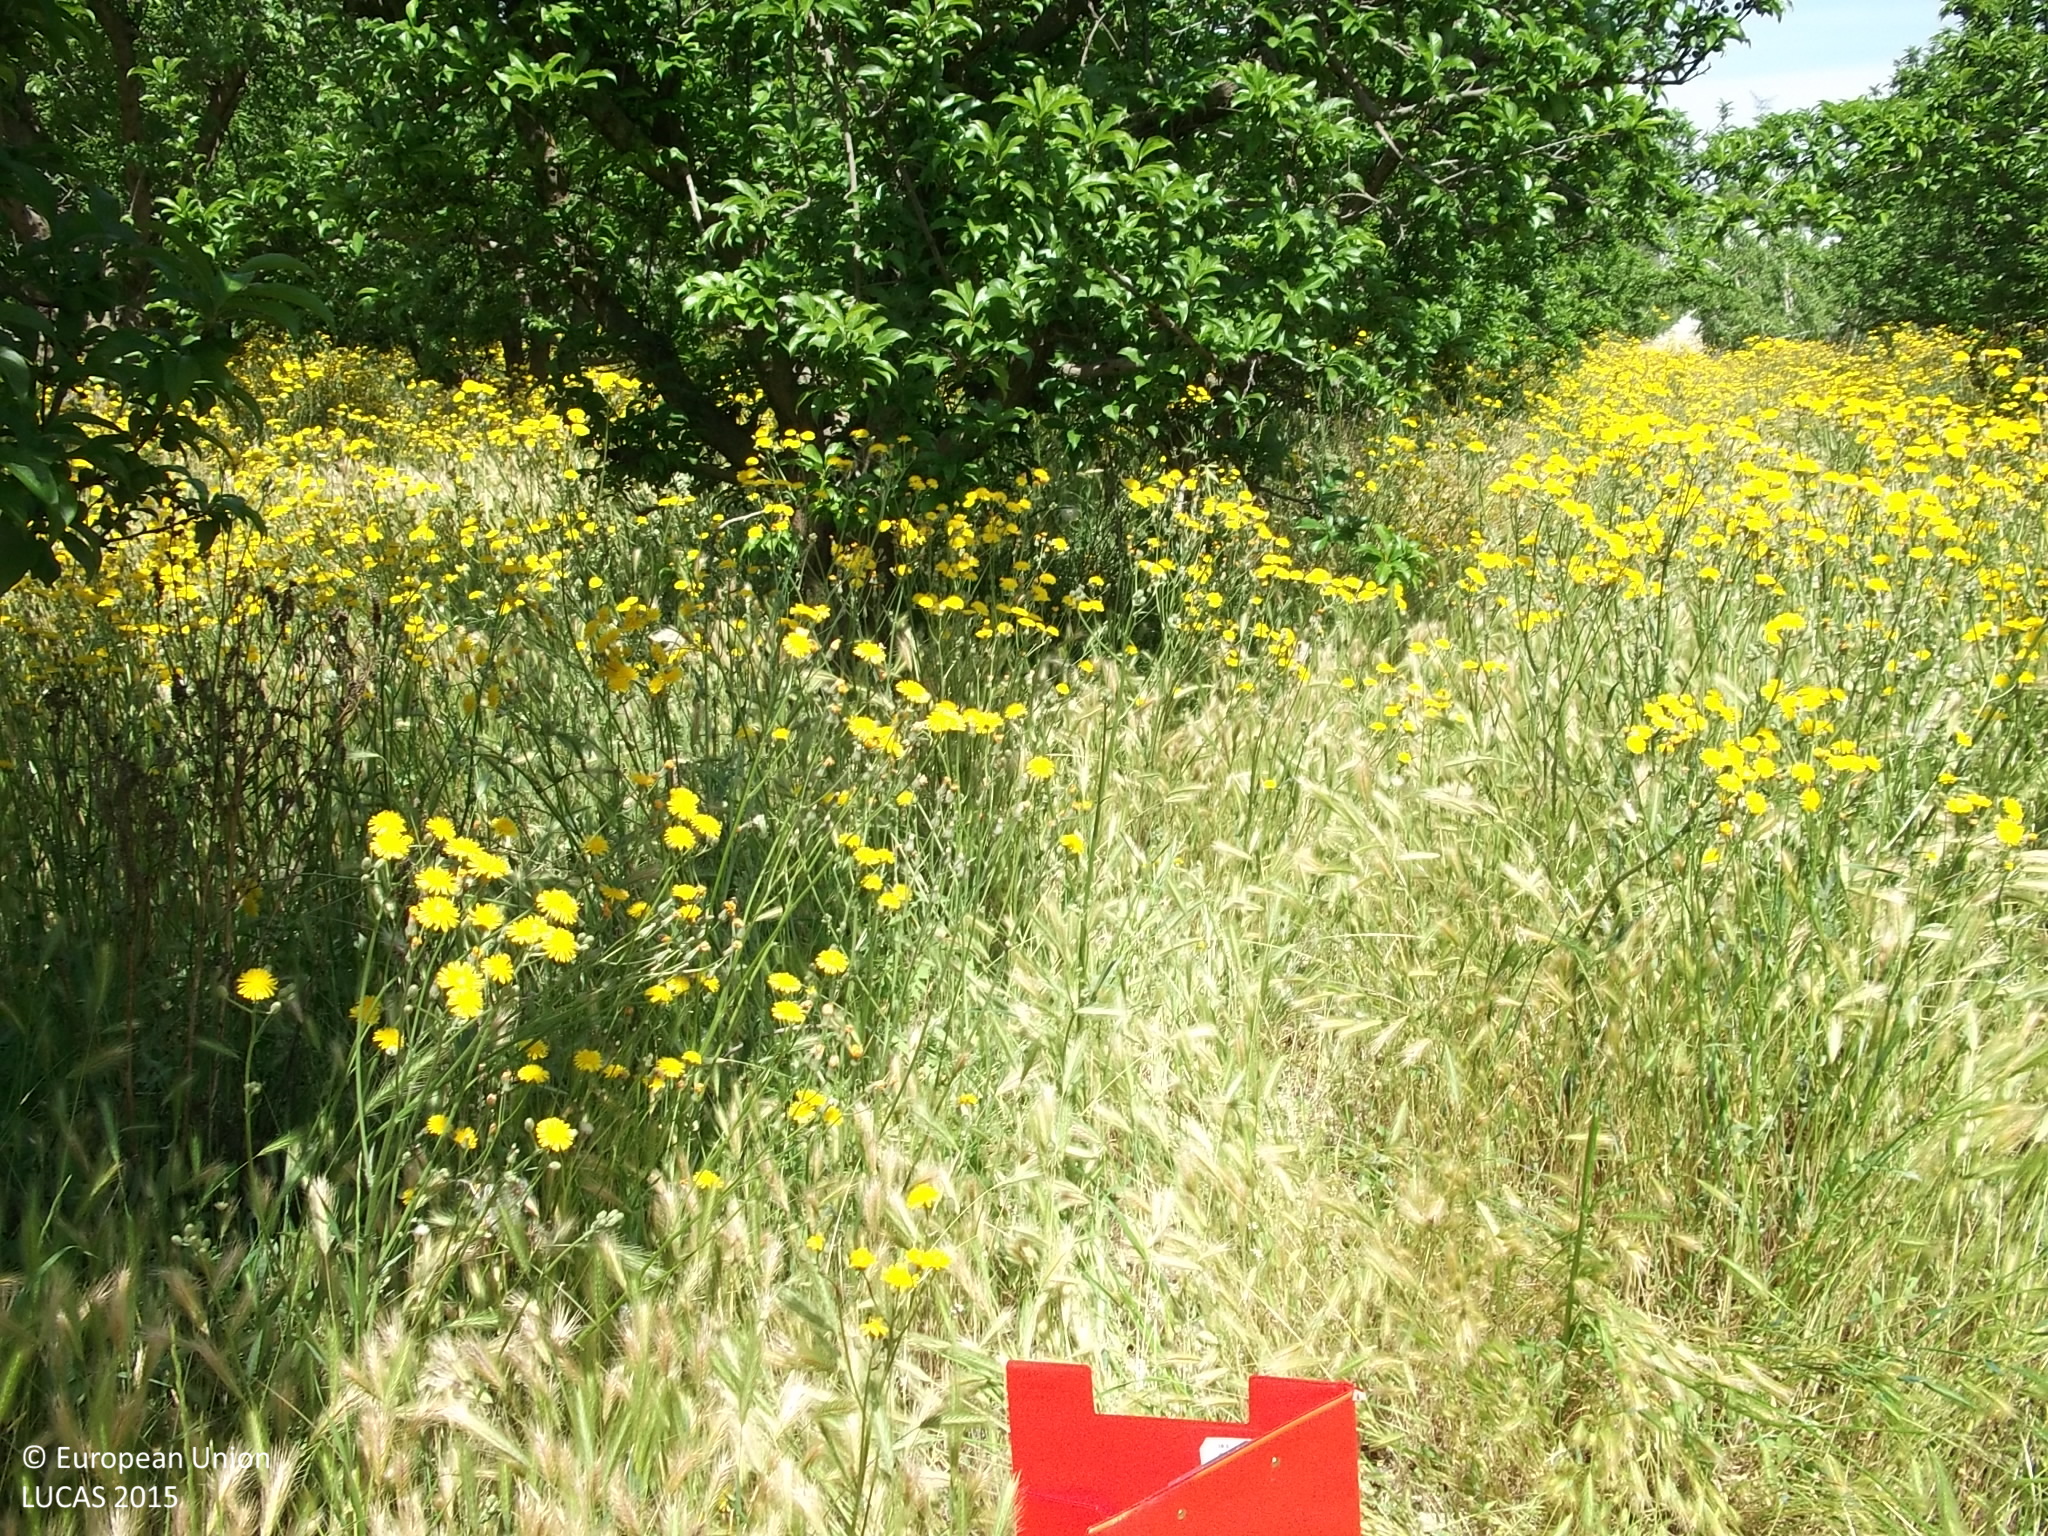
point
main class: Cropland
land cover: Other fruit trees and berries
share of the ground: 25 - 50 %
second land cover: Spontaneously vegetated surfaces
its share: 50 - 75 %
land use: Agriculture (excluding fallow land and kitchen gardens)
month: April
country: ES
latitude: 38.2595
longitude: -1.6124
